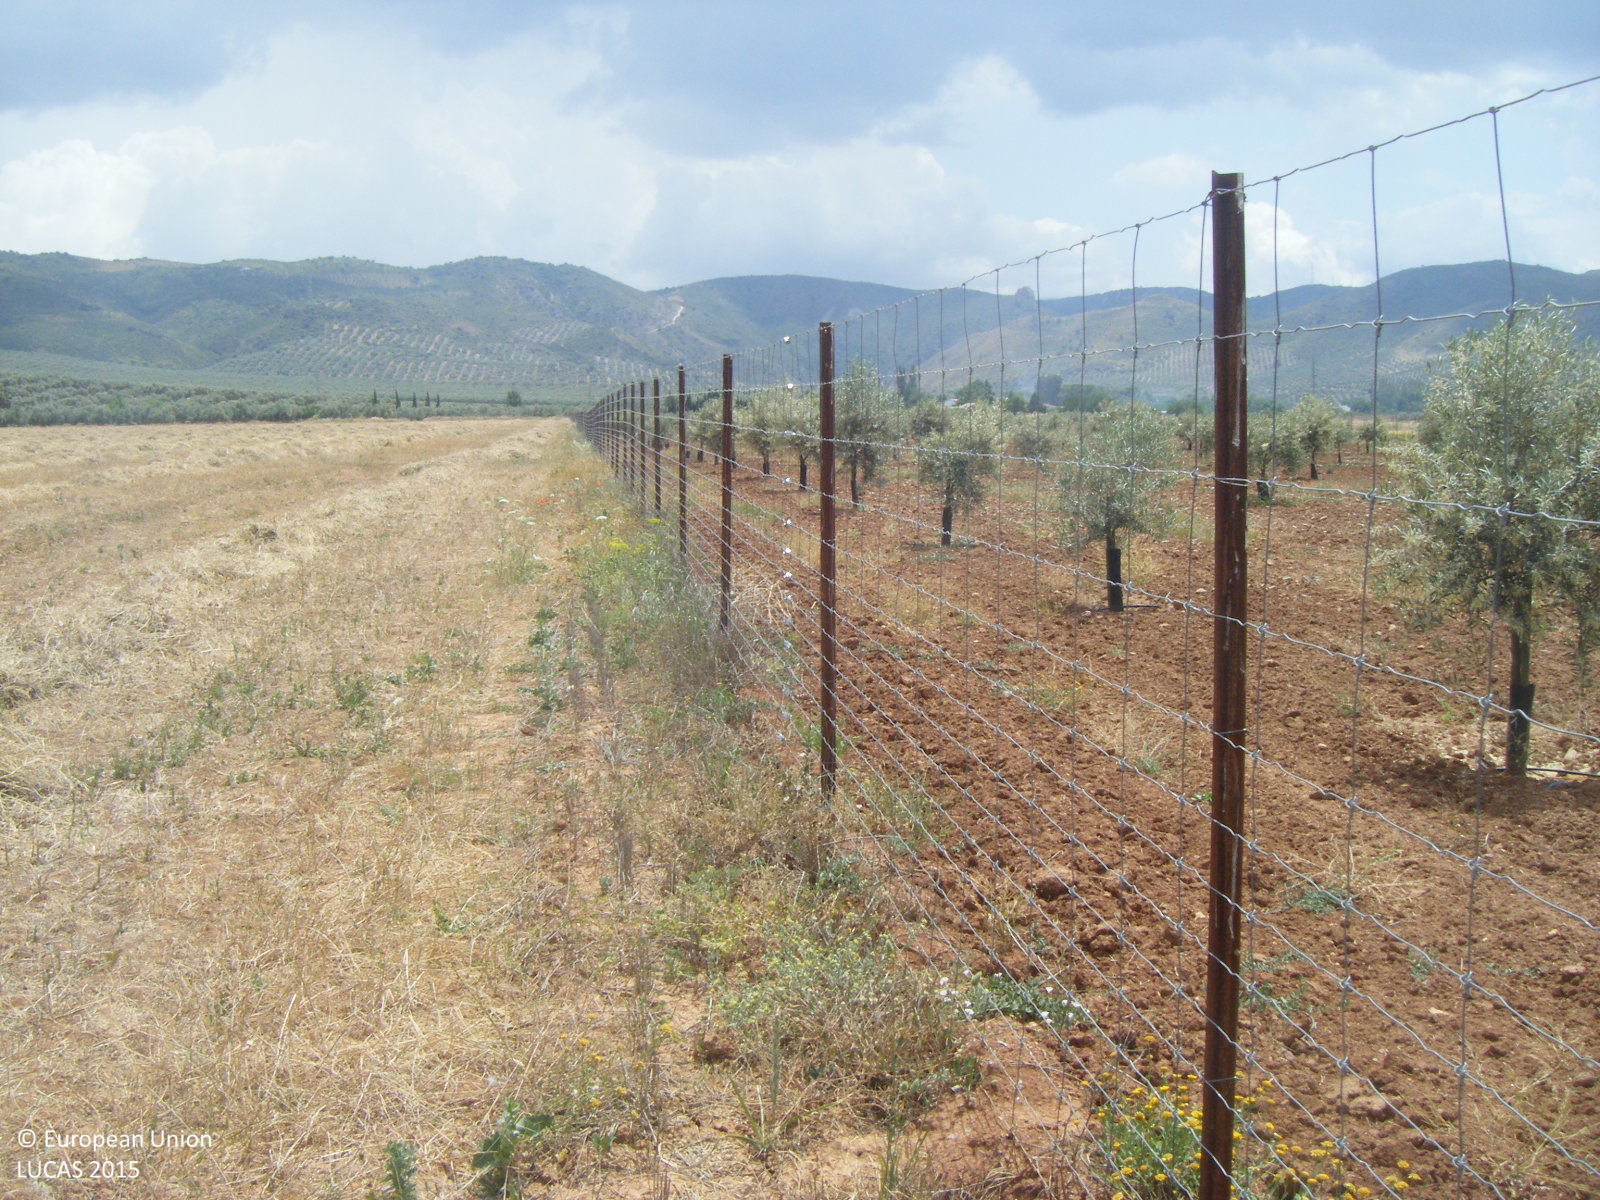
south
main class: Cropland
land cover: Olive groves
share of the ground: < 10 %
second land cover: Other bare soil
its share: > 75 %
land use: Agriculture (excluding fallow land and kitchen gardens)
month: May
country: ES
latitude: 37.0822
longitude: -4.4289
